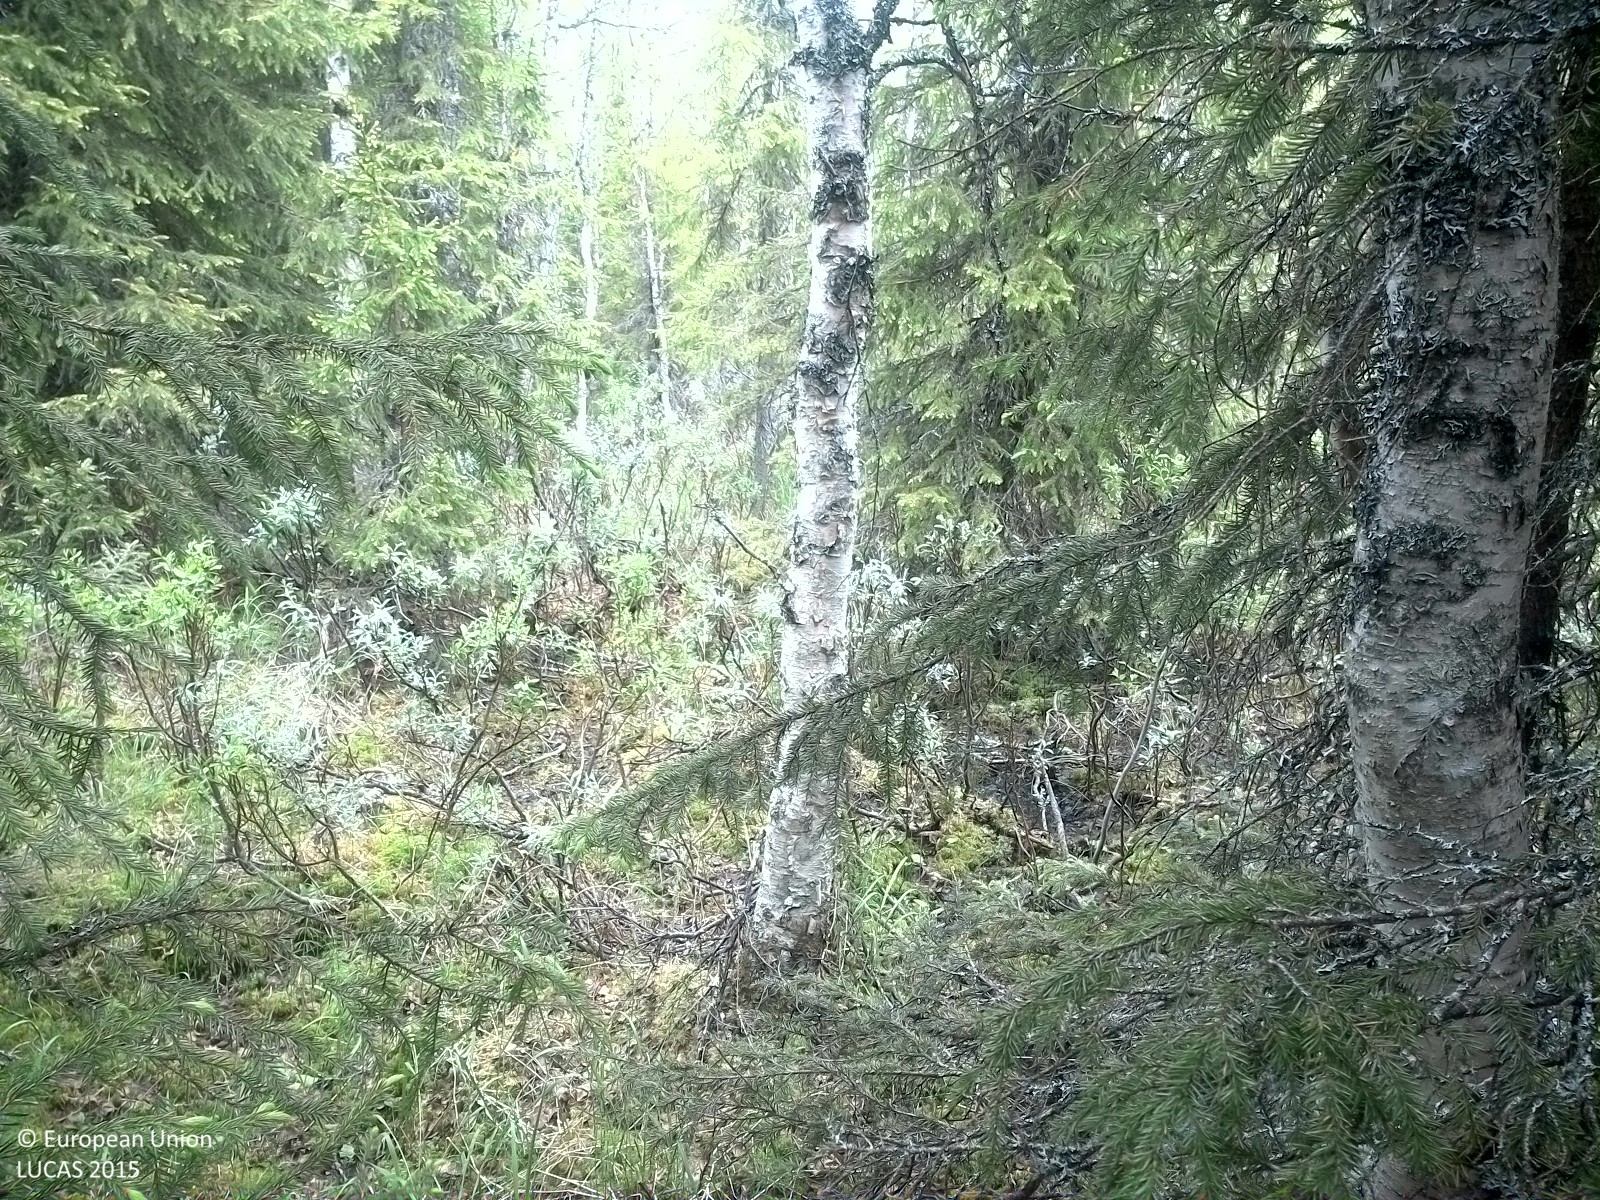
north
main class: Woodland
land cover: Spruce dominated mixed woodland
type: boreal forest
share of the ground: > 75 %
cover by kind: coniferous forest trees 60 %, broadleaved forest trees 25 %, shrubs 15 %
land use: Forestry
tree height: > 5 m
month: June
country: SE
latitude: 63.4675
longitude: 15.0528
